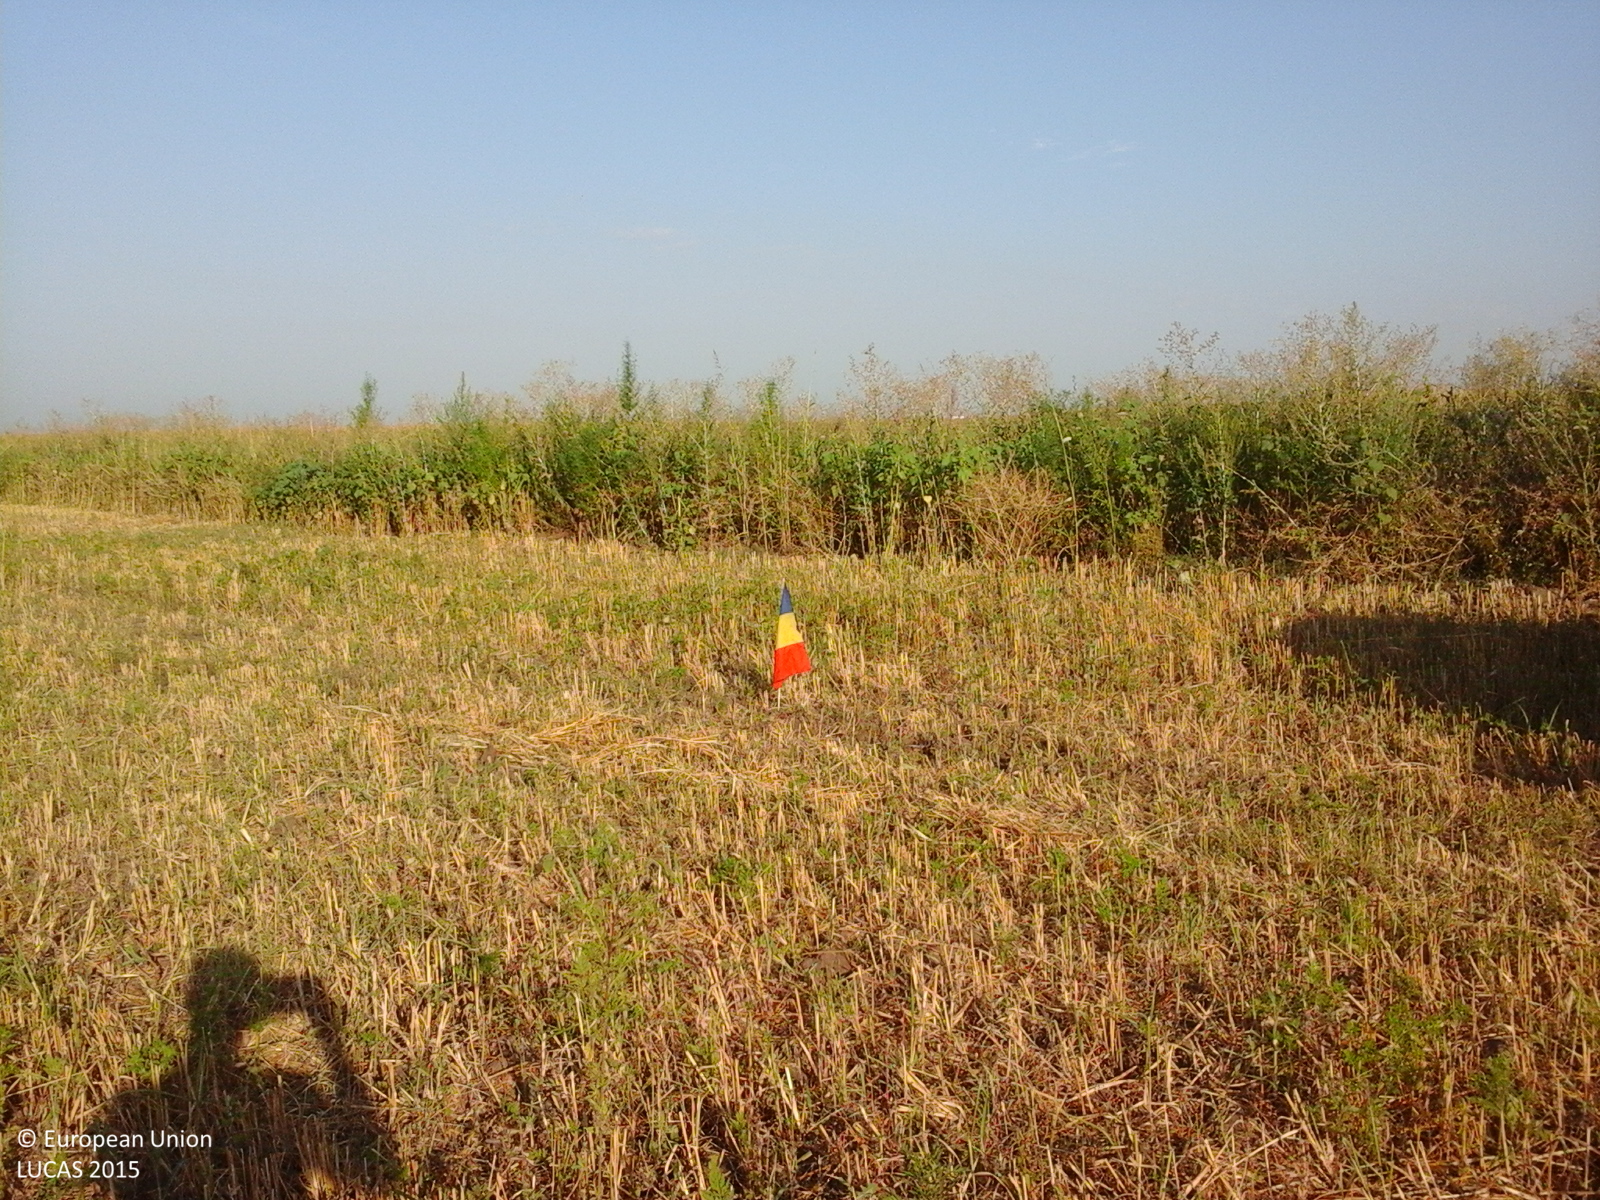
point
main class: Cropland
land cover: Oats
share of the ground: > 75 %
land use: Agriculture (excluding fallow land and kitchen gardens)
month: August
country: RO
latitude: 44.0669
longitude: 23.2168
